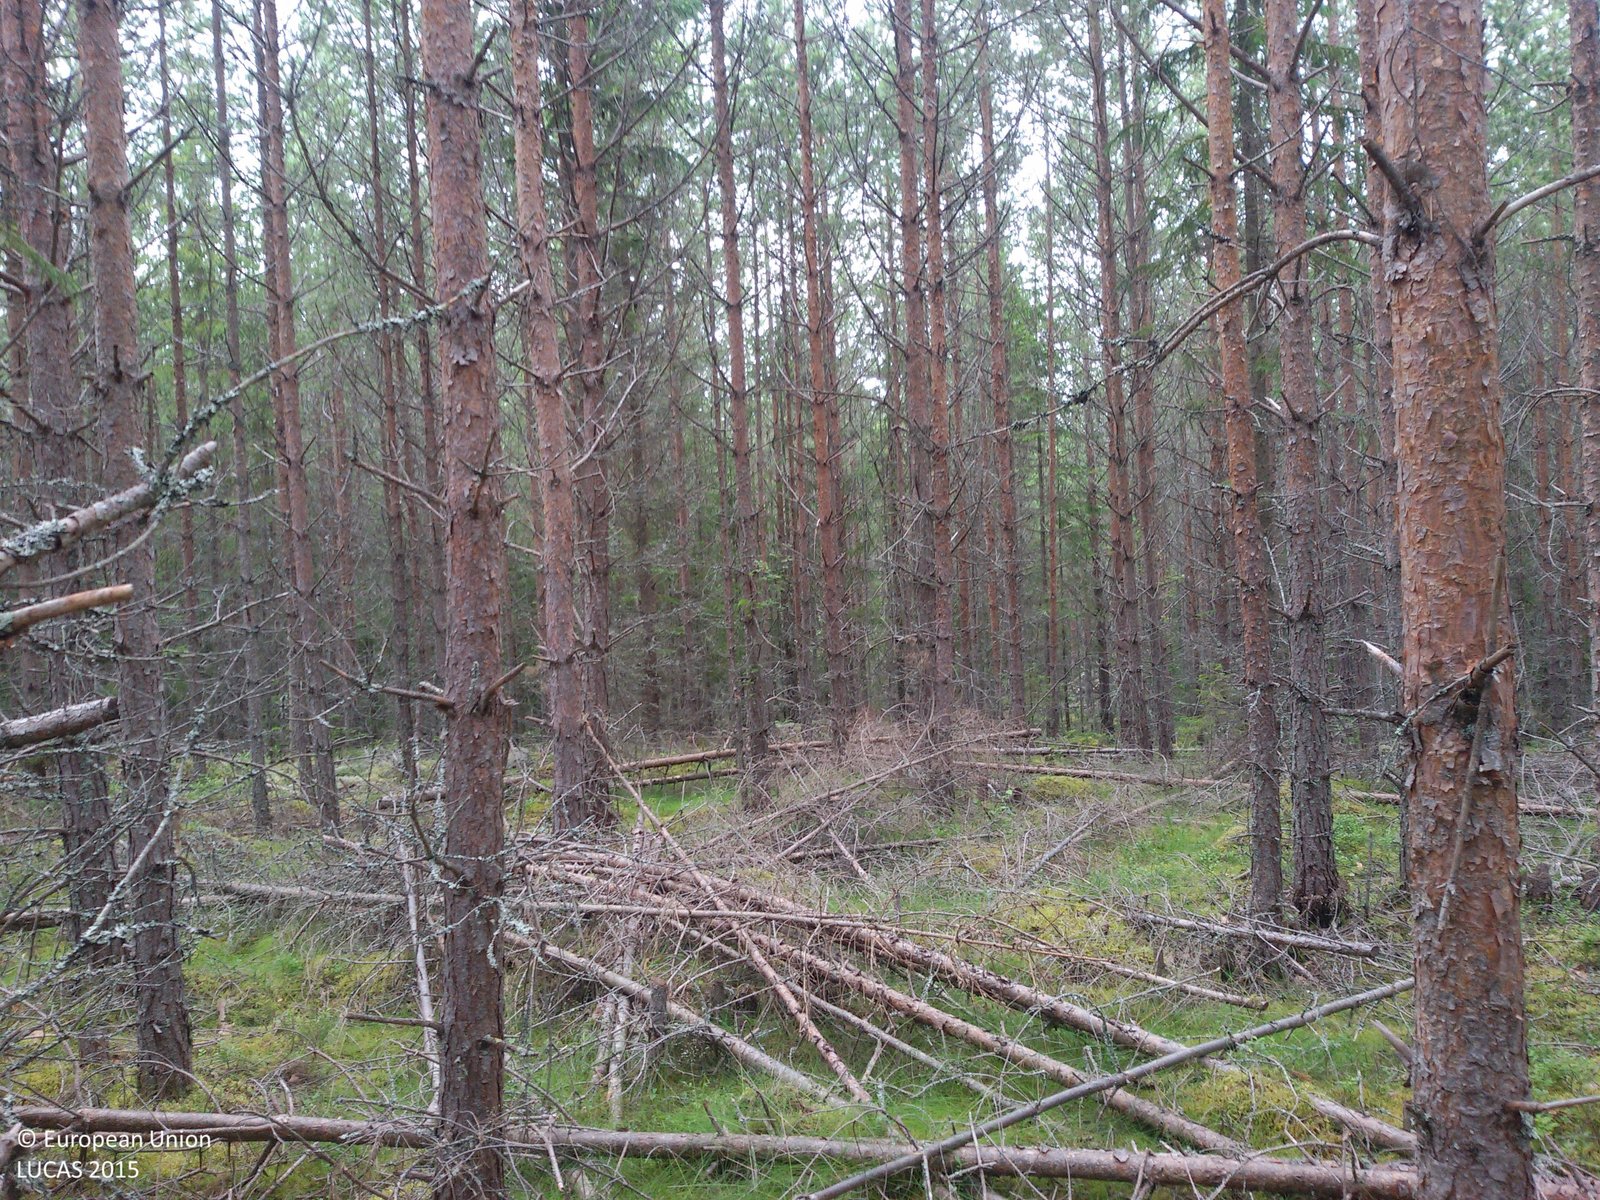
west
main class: Woodland
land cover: Pine dominated coniferous woodland
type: boreal forest
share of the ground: > 75 %
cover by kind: coniferous forest trees 80 %, shrubs 20 %
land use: Forestry
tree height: > 5 m
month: July
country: SE
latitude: 60.5085
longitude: 15.9062
